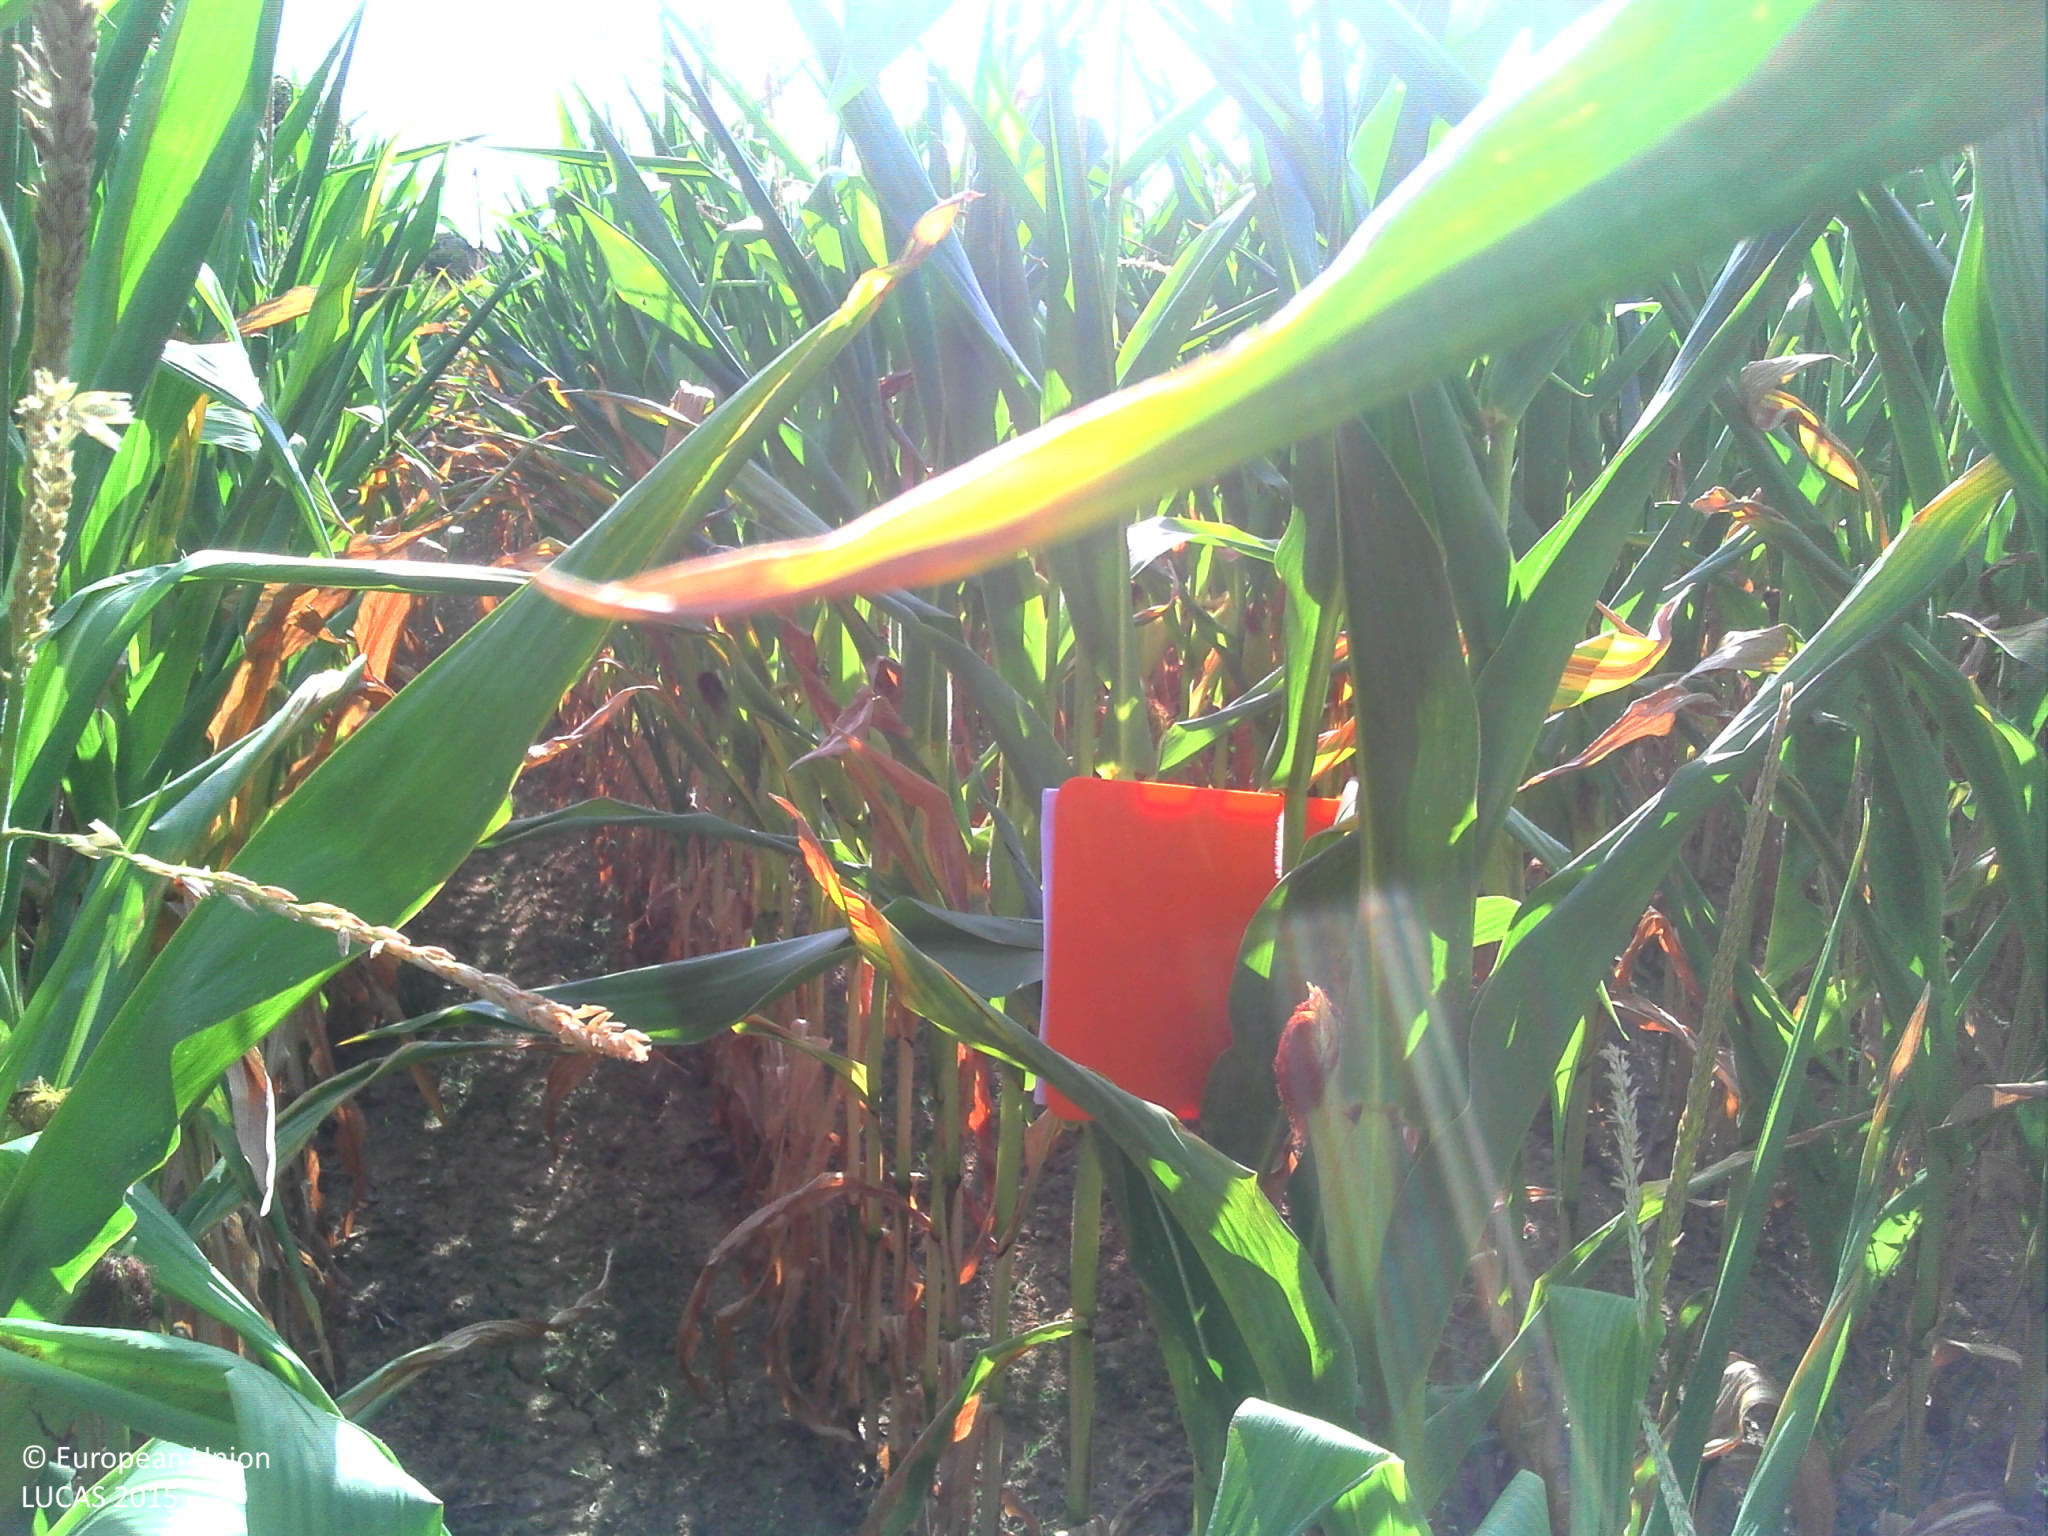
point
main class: Cropland
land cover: Maize
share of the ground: > 75 %
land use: Agriculture (excluding fallow land and kitchen gardens)
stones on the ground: 10 - 25 %
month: August
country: FR
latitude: 46.6577
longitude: -1.3141
